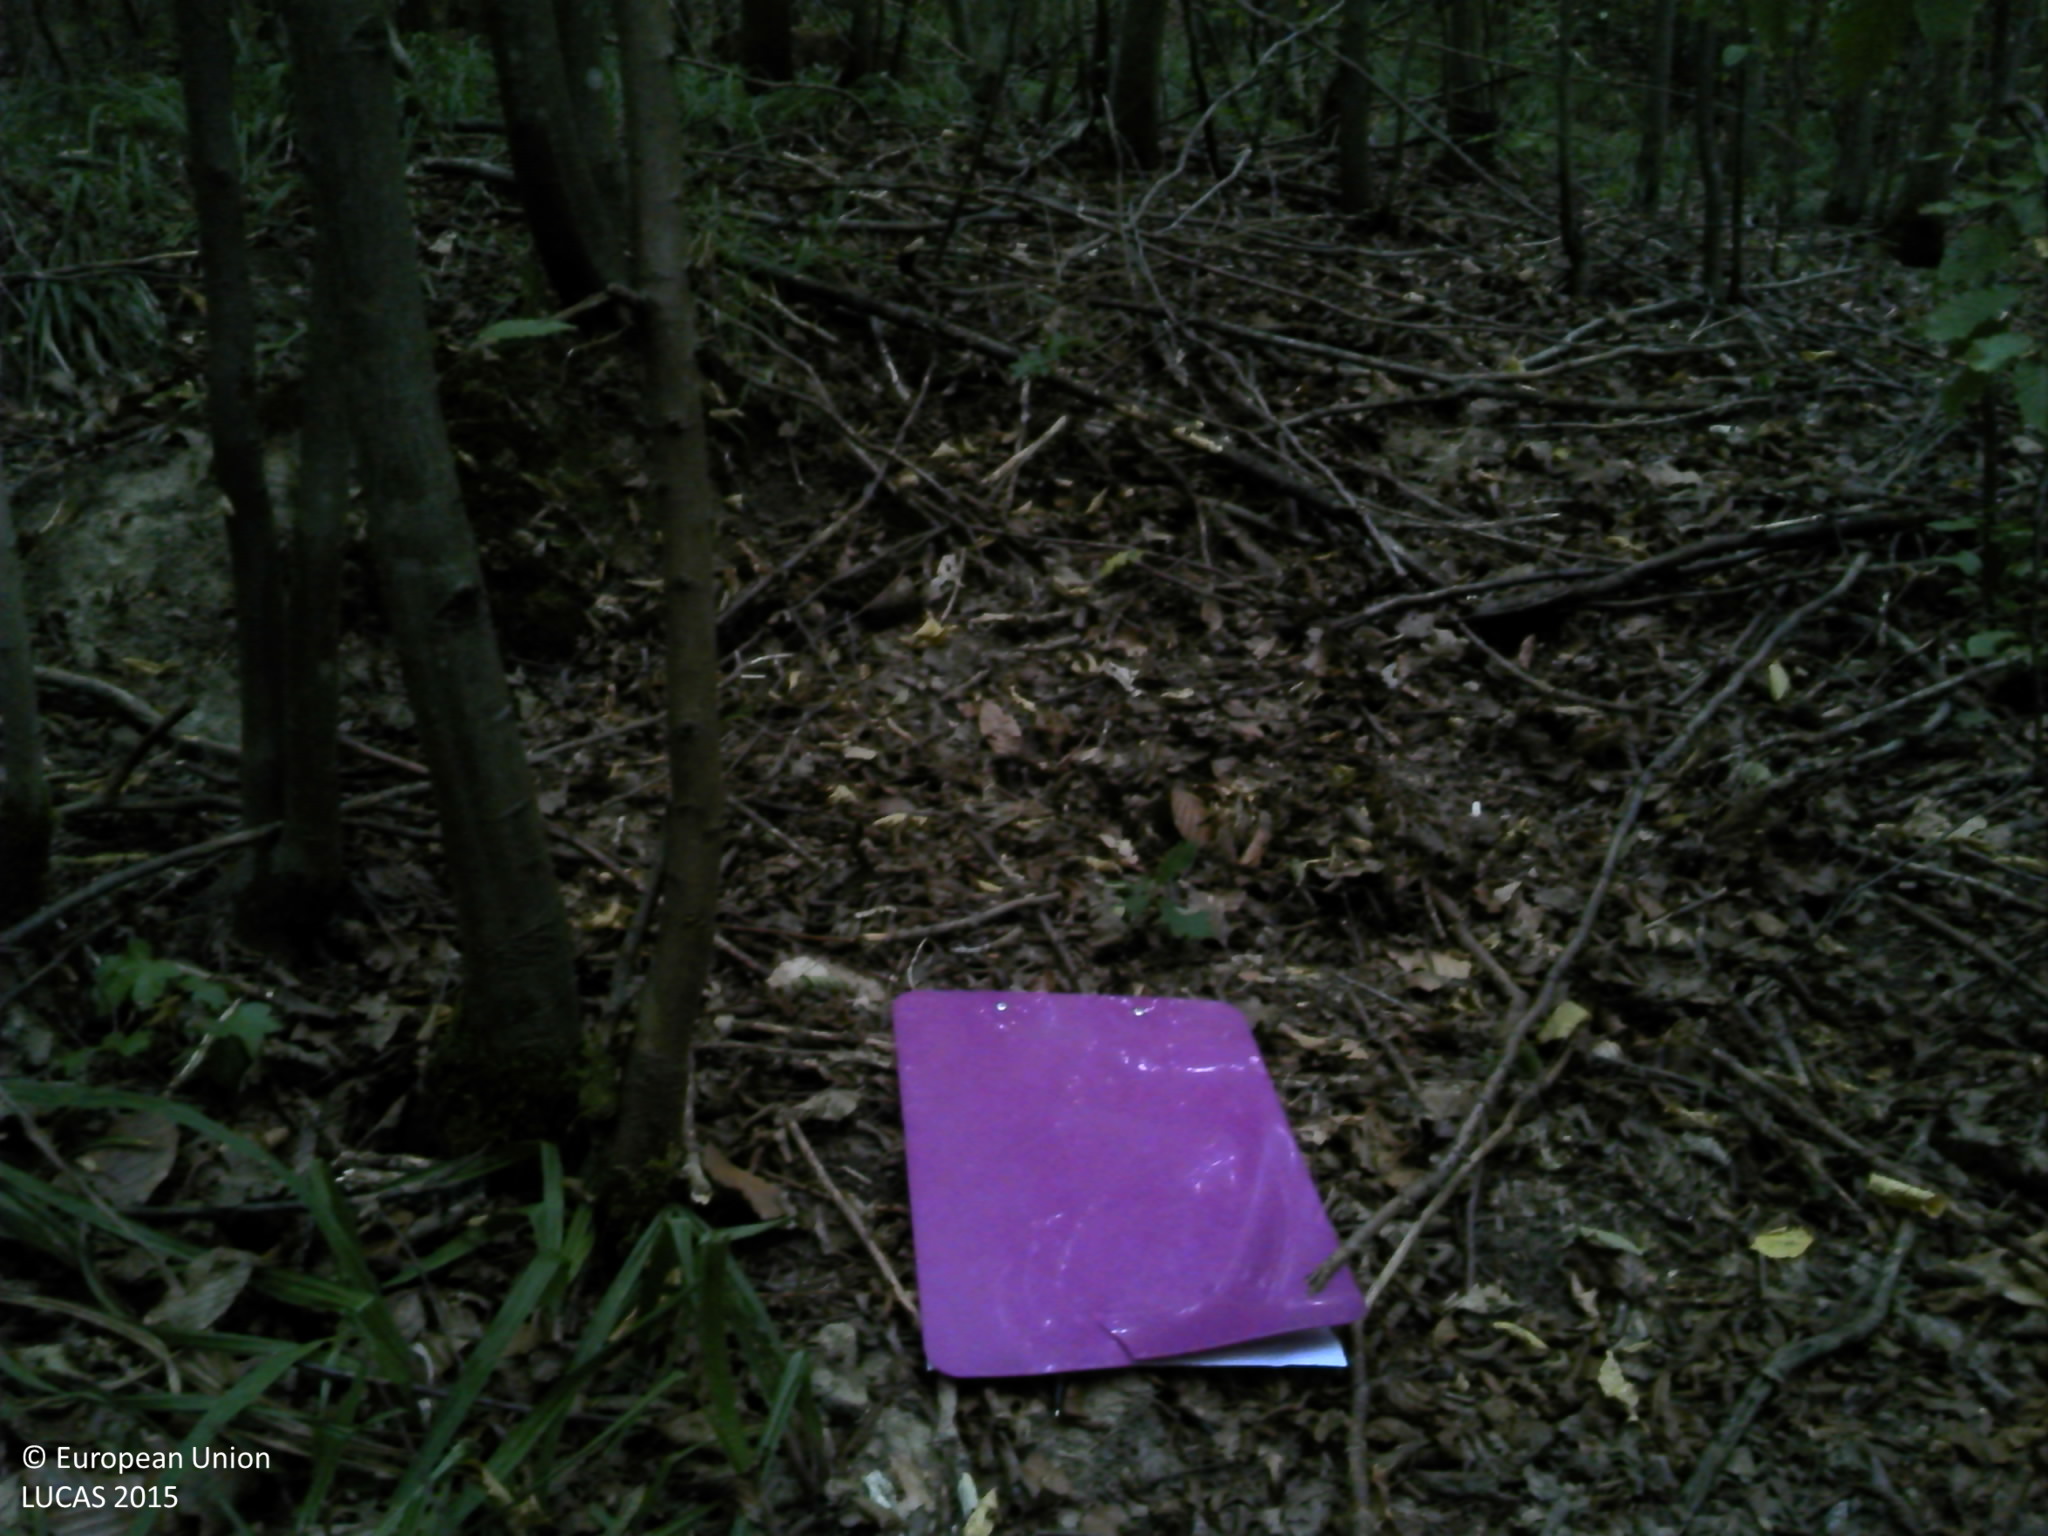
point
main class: Woodland
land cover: Broadleaved woodland
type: beech forest
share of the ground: > 75 %
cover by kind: broadleaved forest trees 100 %
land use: Forestry
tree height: < 5 m
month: August
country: HR
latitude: 45.4146
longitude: 18.0412
